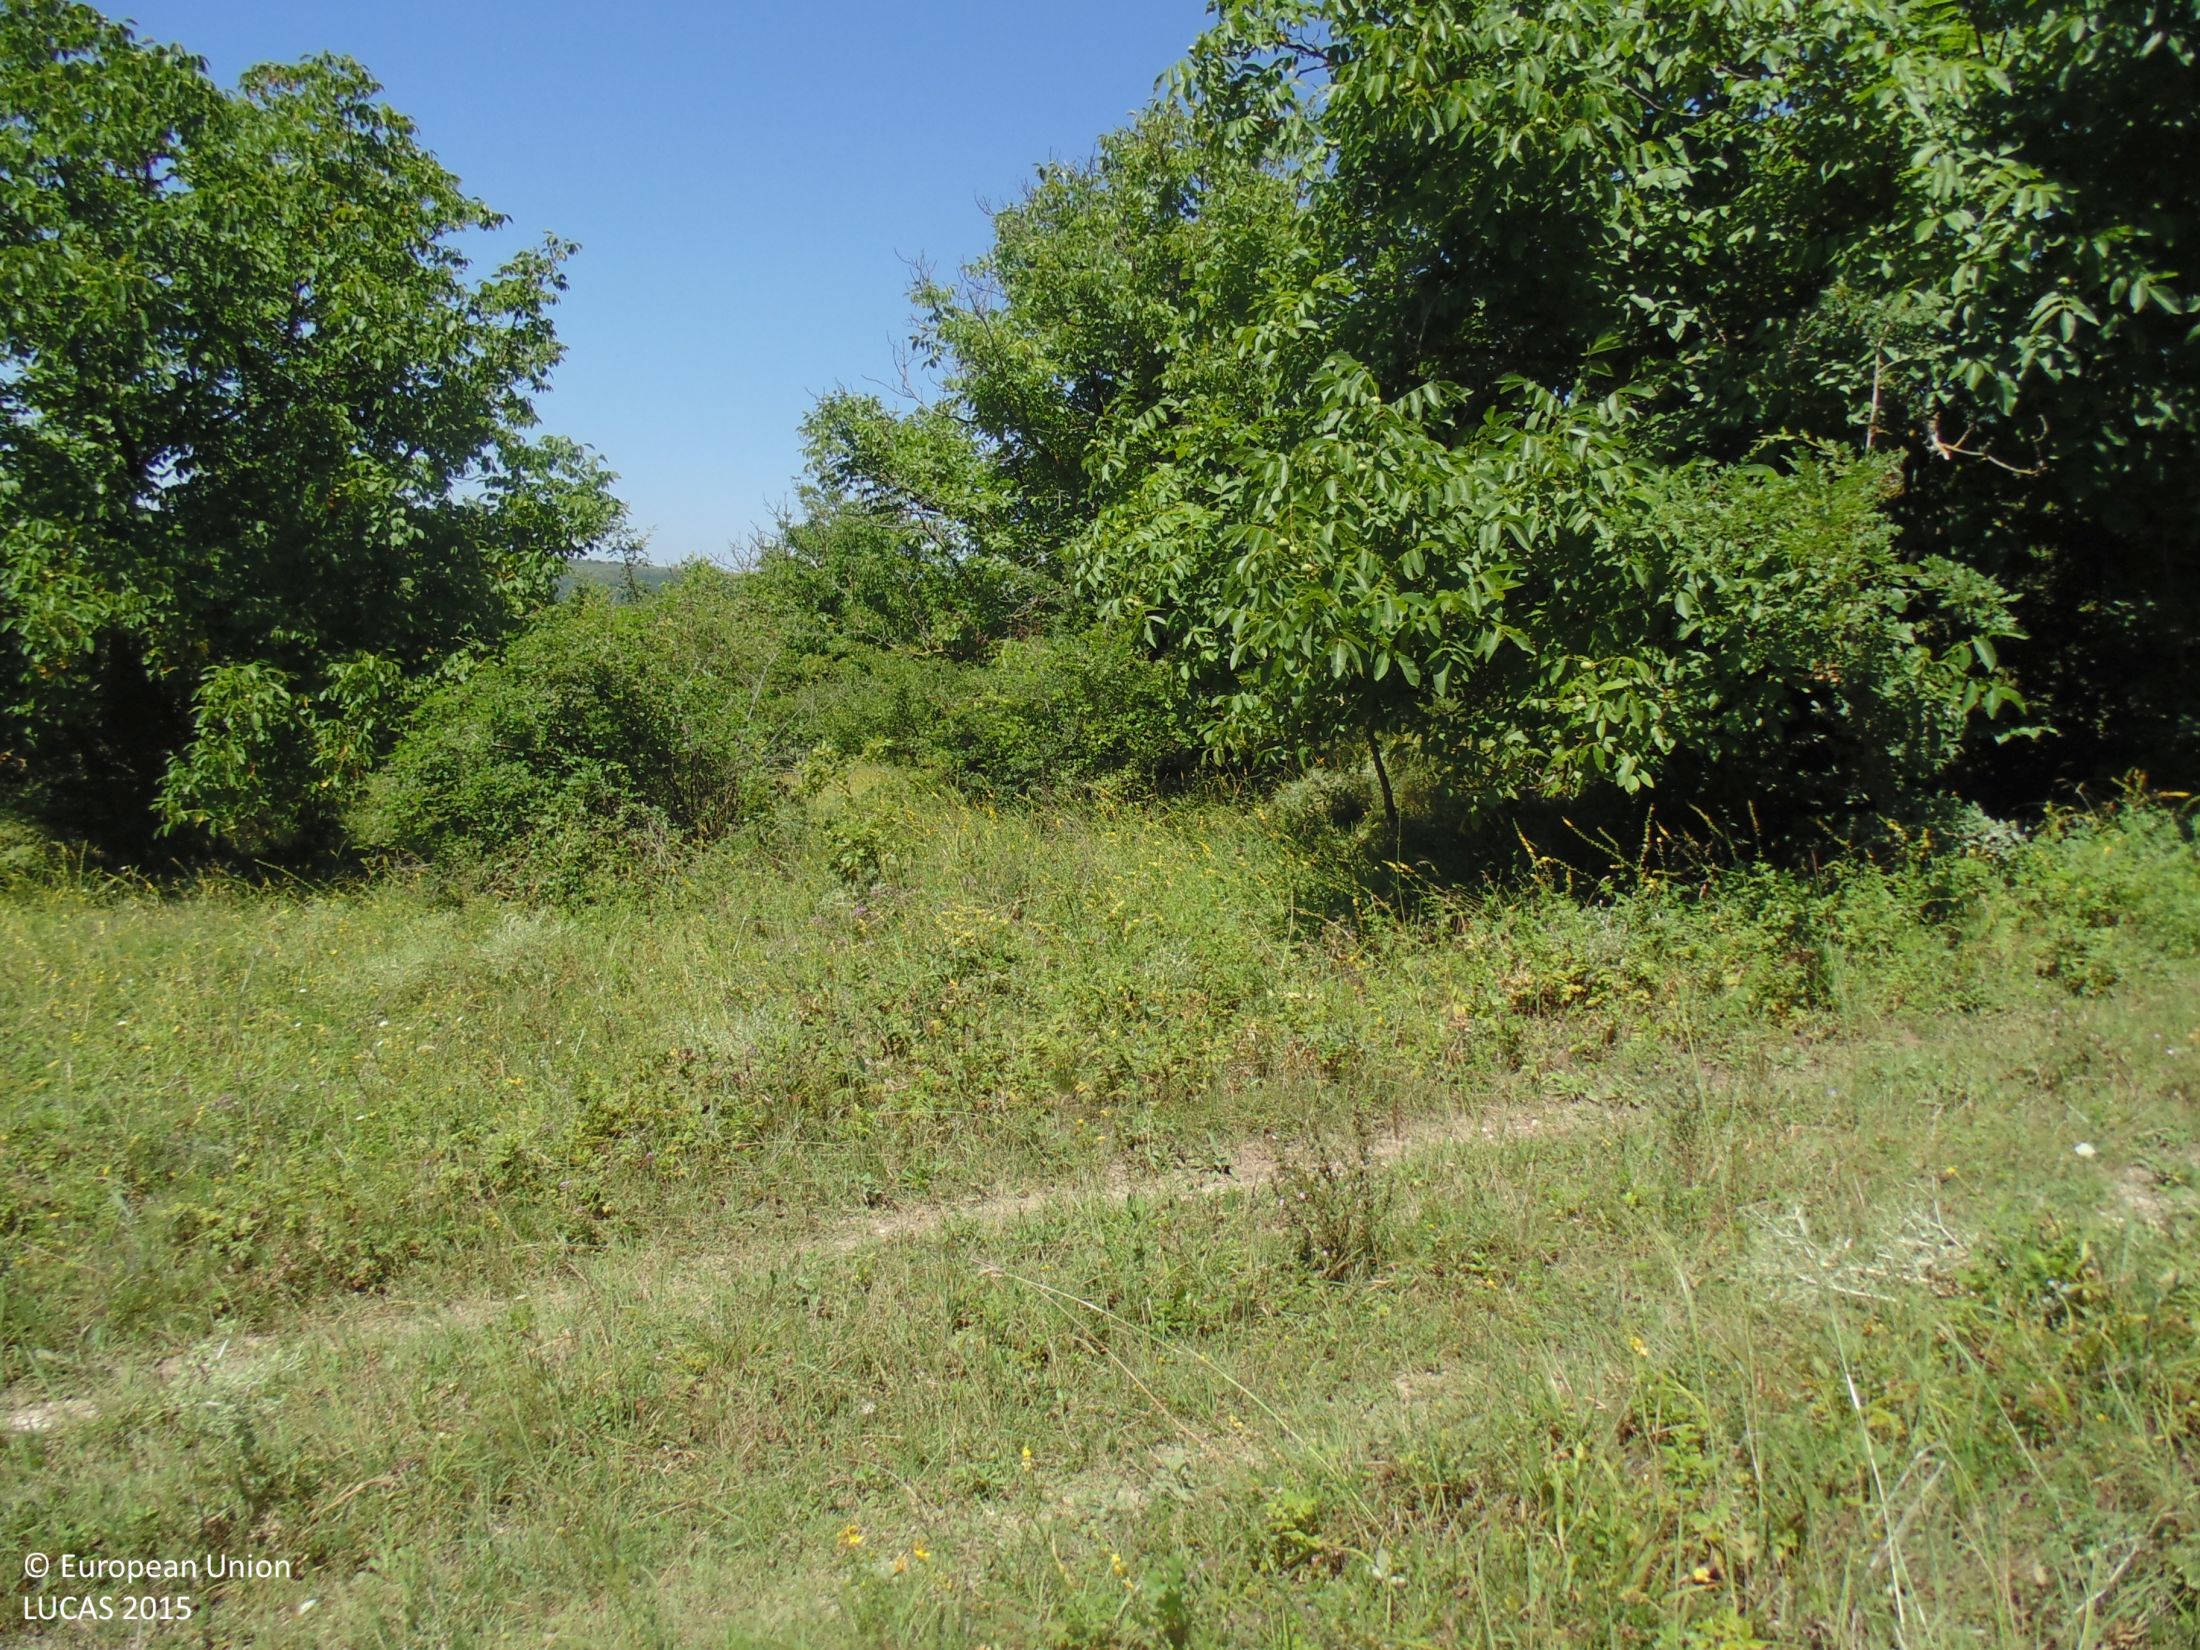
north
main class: Woodland
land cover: Broadleaved woodland
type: mesophytic deciduous forest
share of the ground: > 75 %
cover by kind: broadleaved forest trees 80 %, shrubs 15 %, consolidated bare surface 5 %
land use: Forestry
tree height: > 5 m
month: July
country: BG
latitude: 43.3953
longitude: 28.0603
